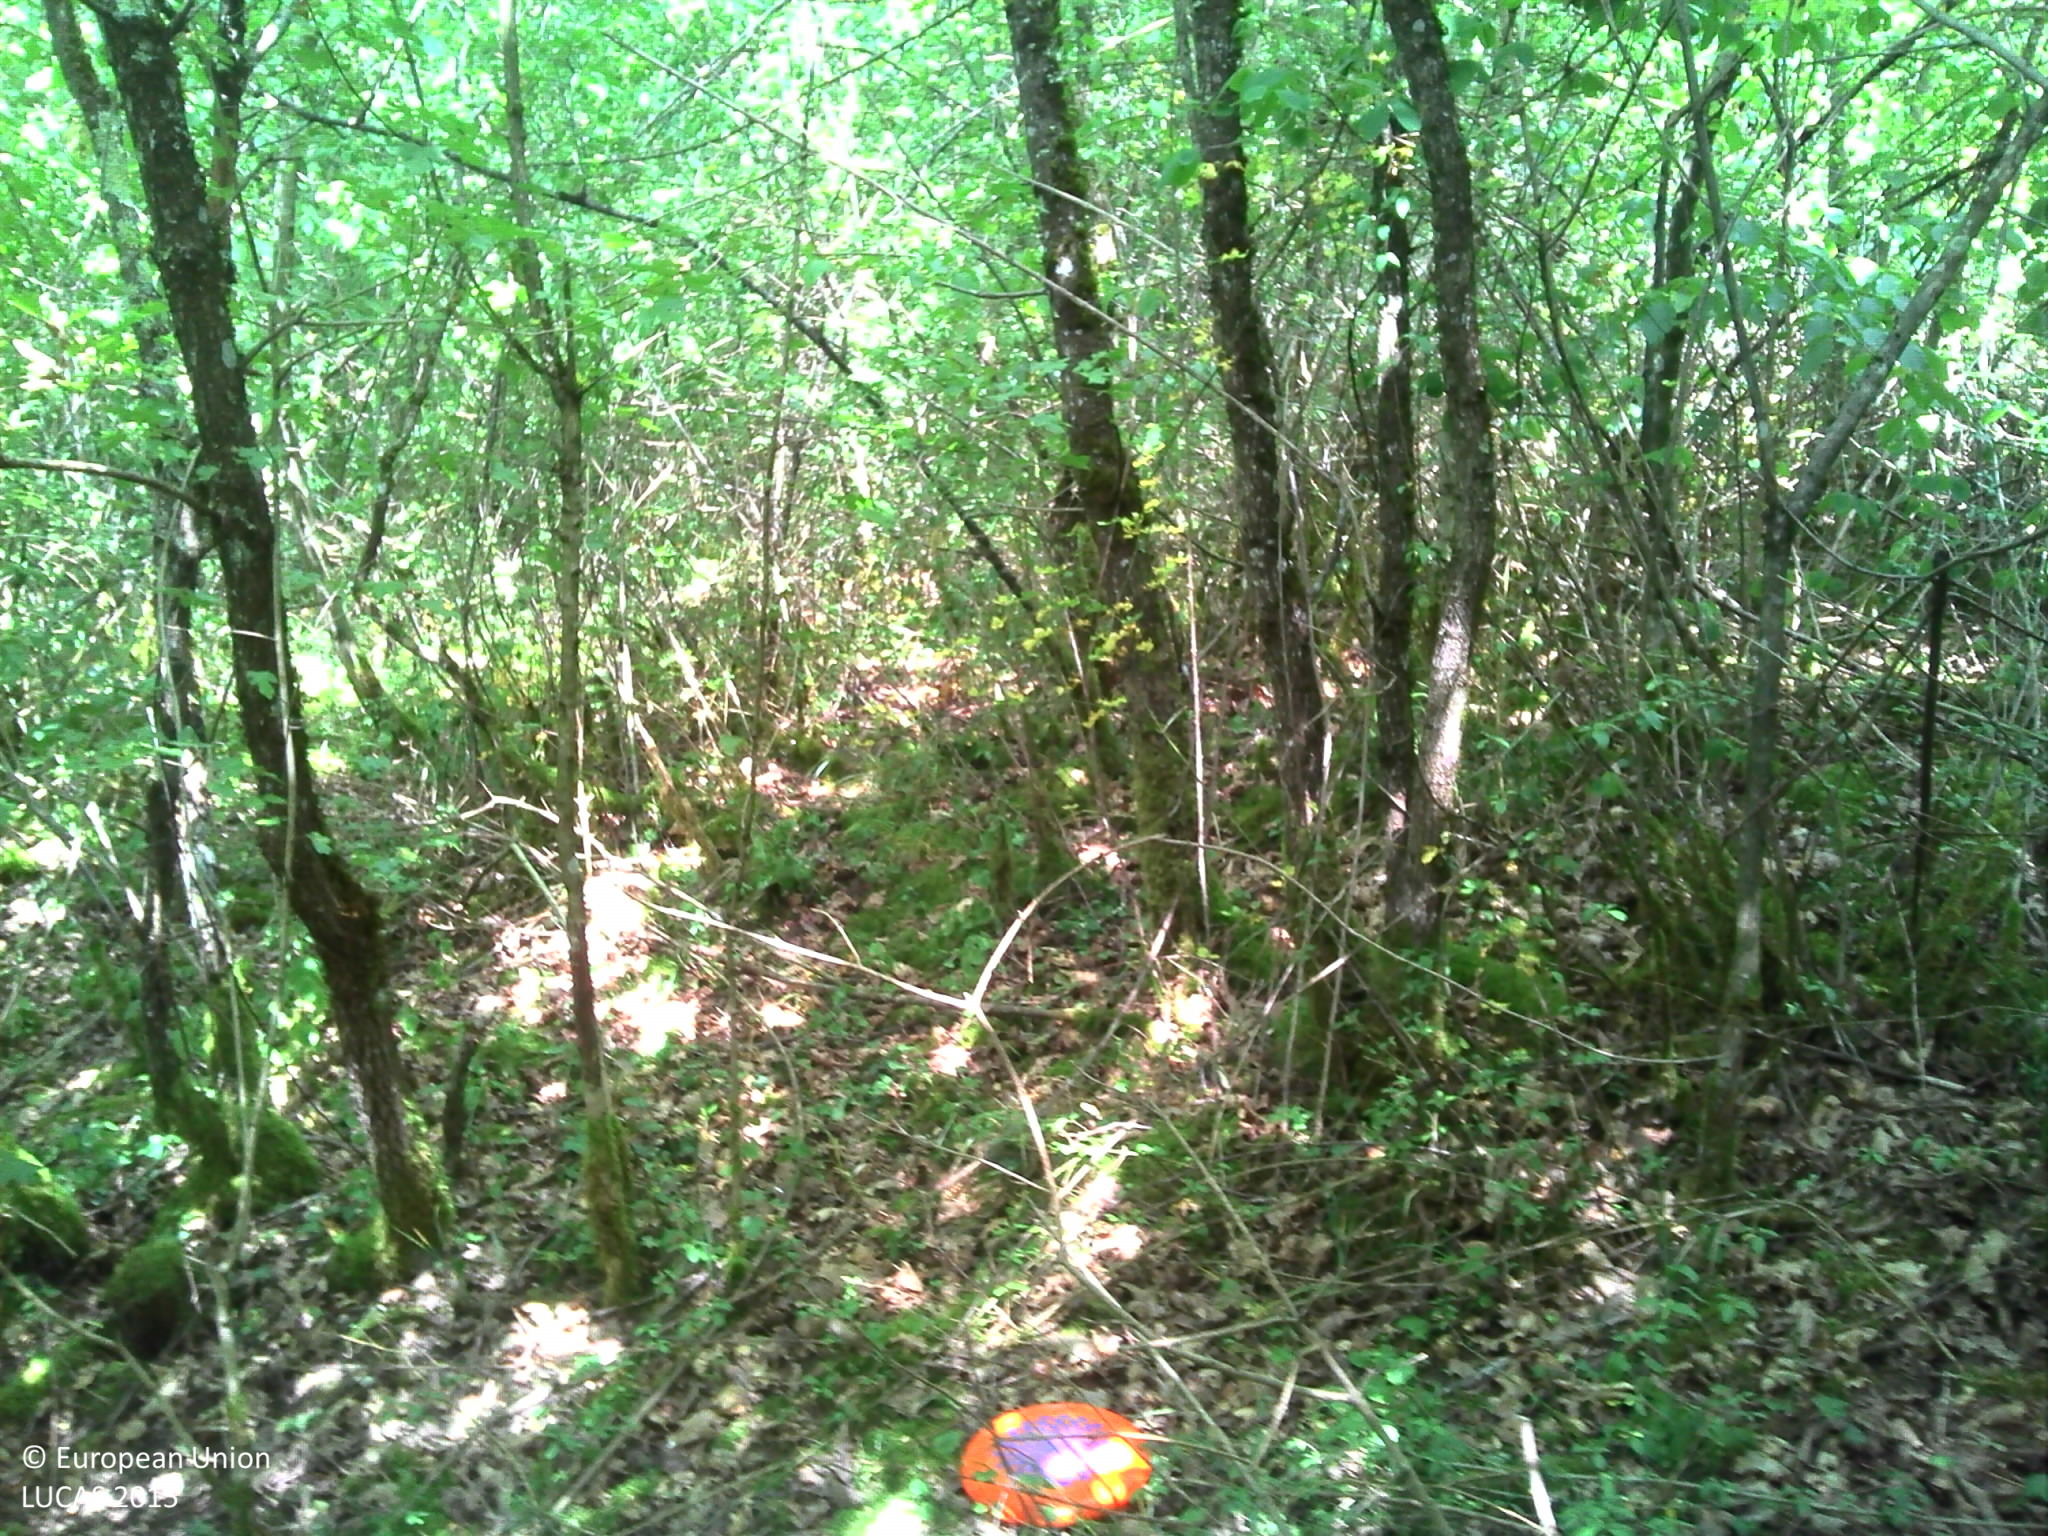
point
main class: Woodland
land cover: Broadleaved woodland
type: mesophytic deciduous forest
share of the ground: > 75 %
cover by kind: broadleaved forest trees 85 %, lichens and mosses 10 %, herbaceous plants 5 %
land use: Forestry
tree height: > 5 m
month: July
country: FR
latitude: 45.6578
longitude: 5.4227
